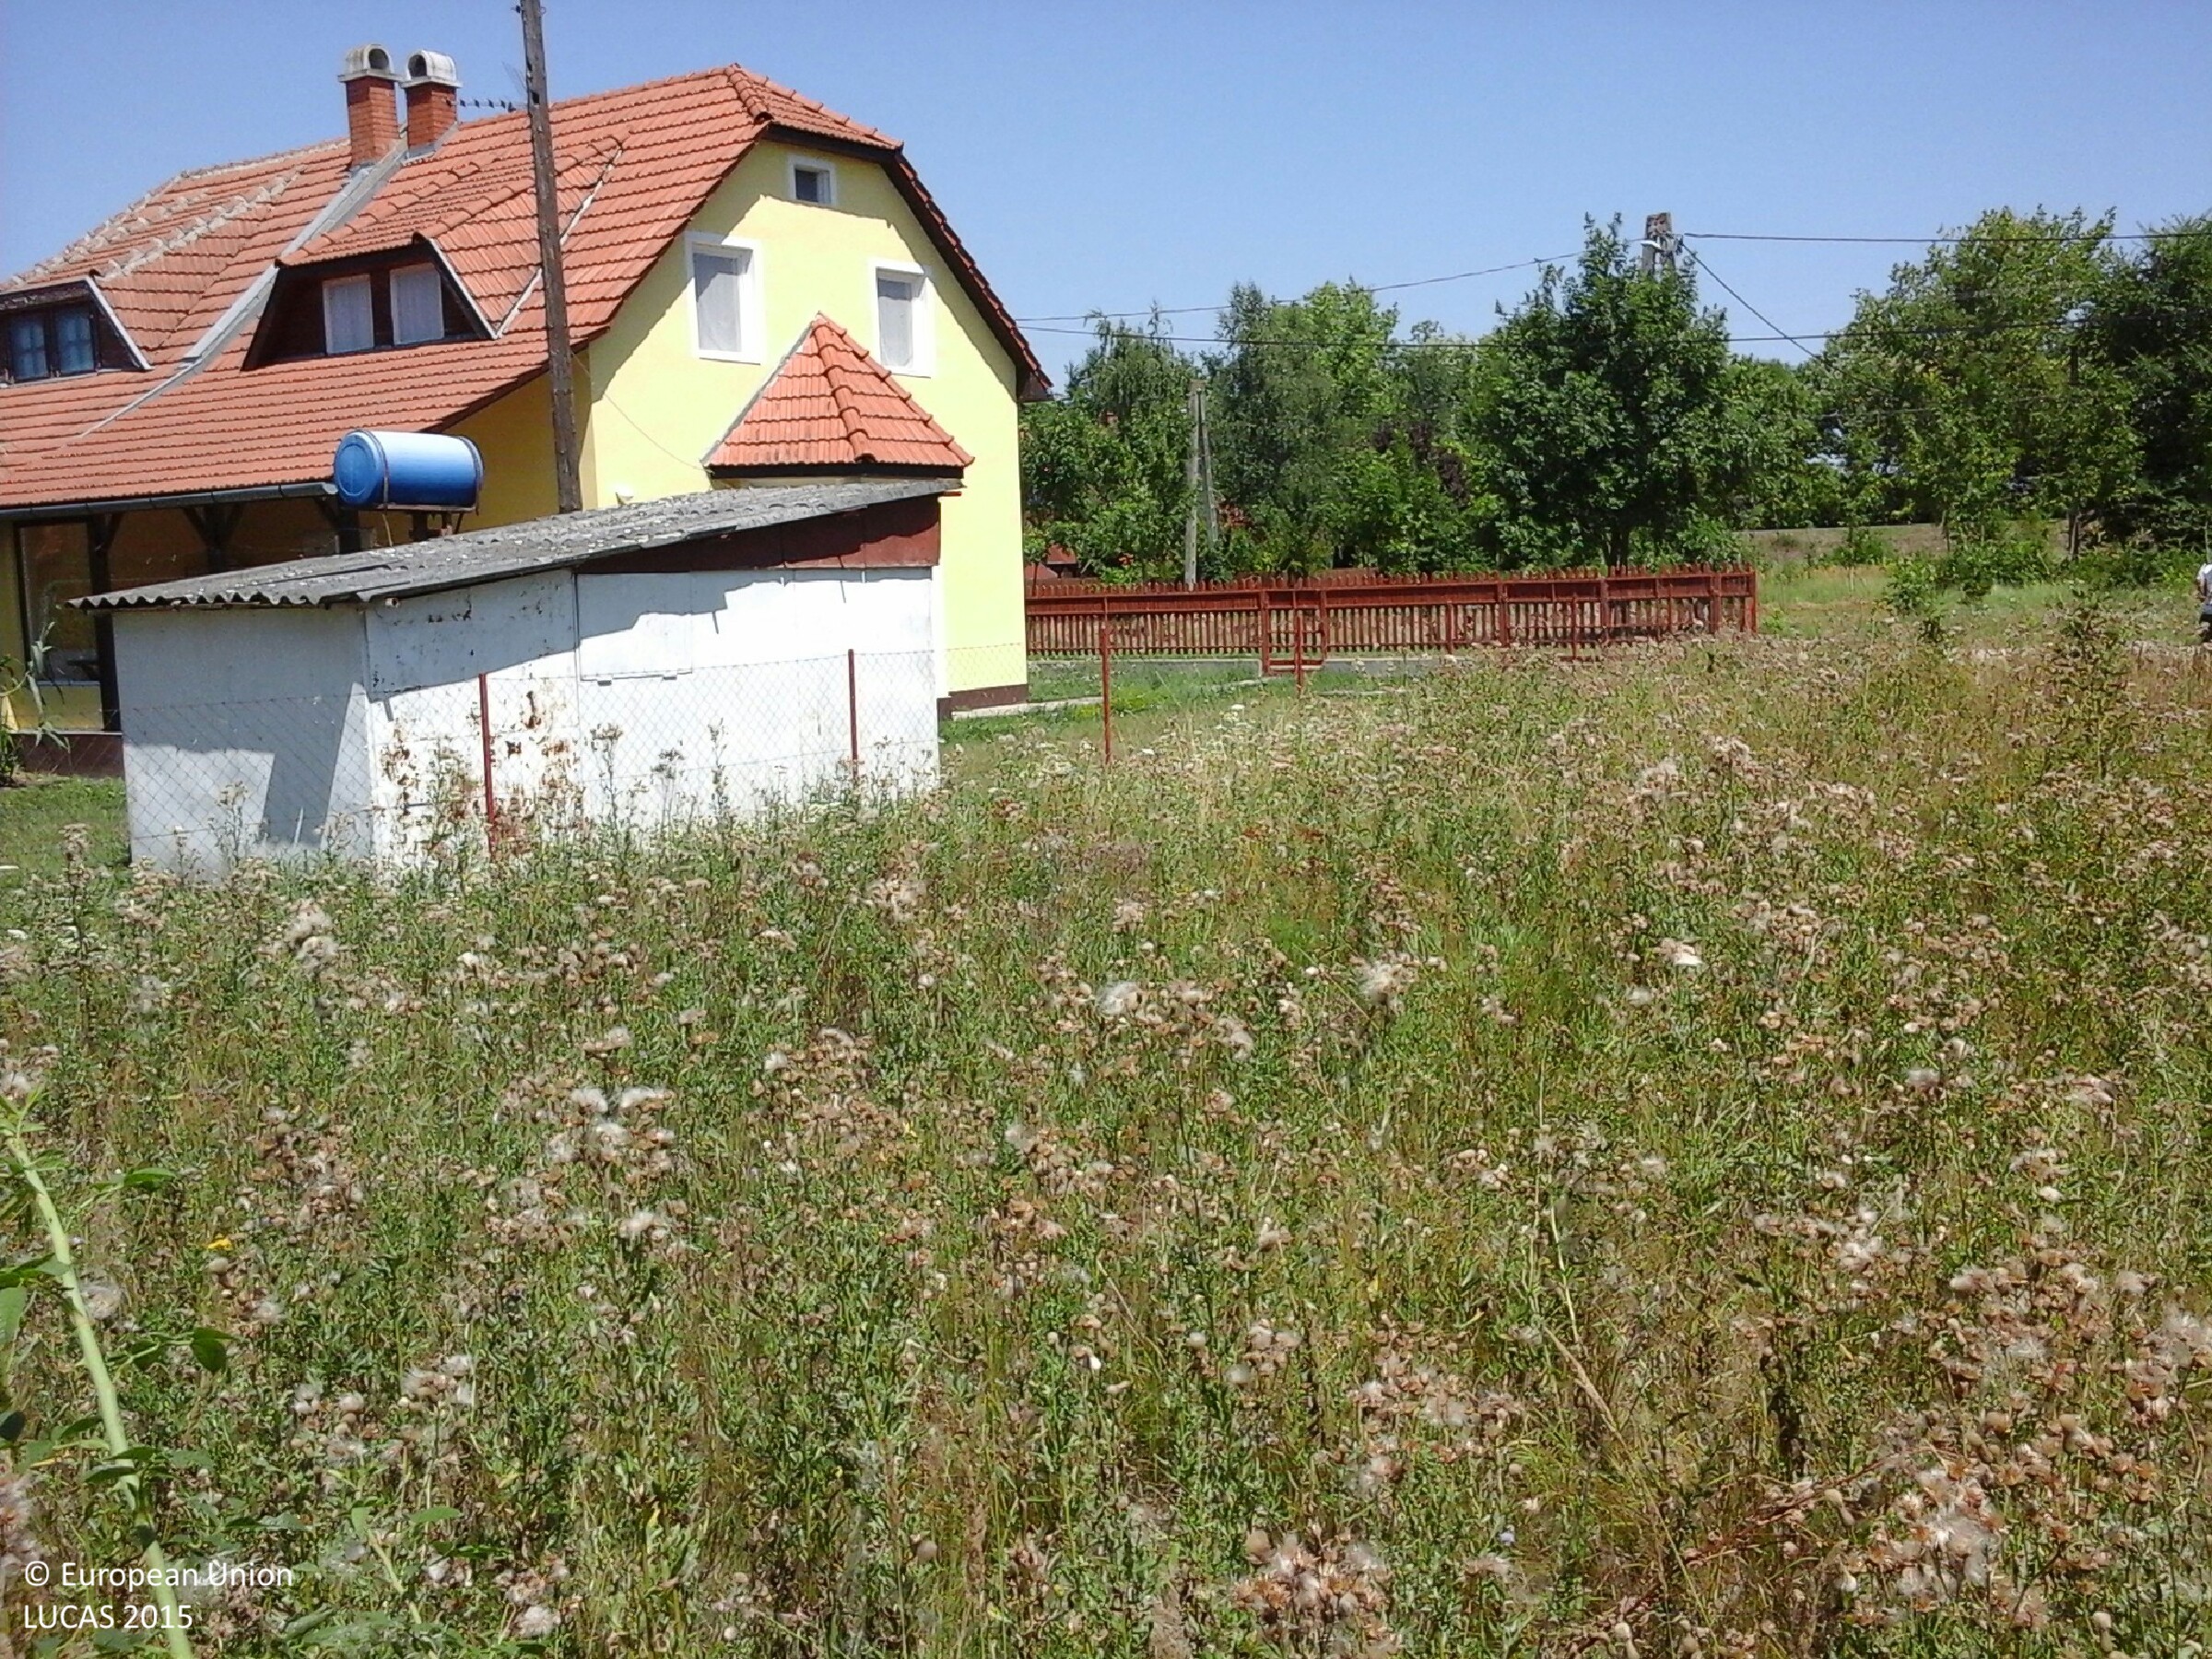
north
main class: Grassland
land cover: Grassland with sparse tree/shrub cover
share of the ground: > 75 %
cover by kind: herbaceous plants 90 %, broadleaved forest trees 5 %, shrubs 5 %
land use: Residential
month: July
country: HU
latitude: 47.5837
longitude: 20.6031
